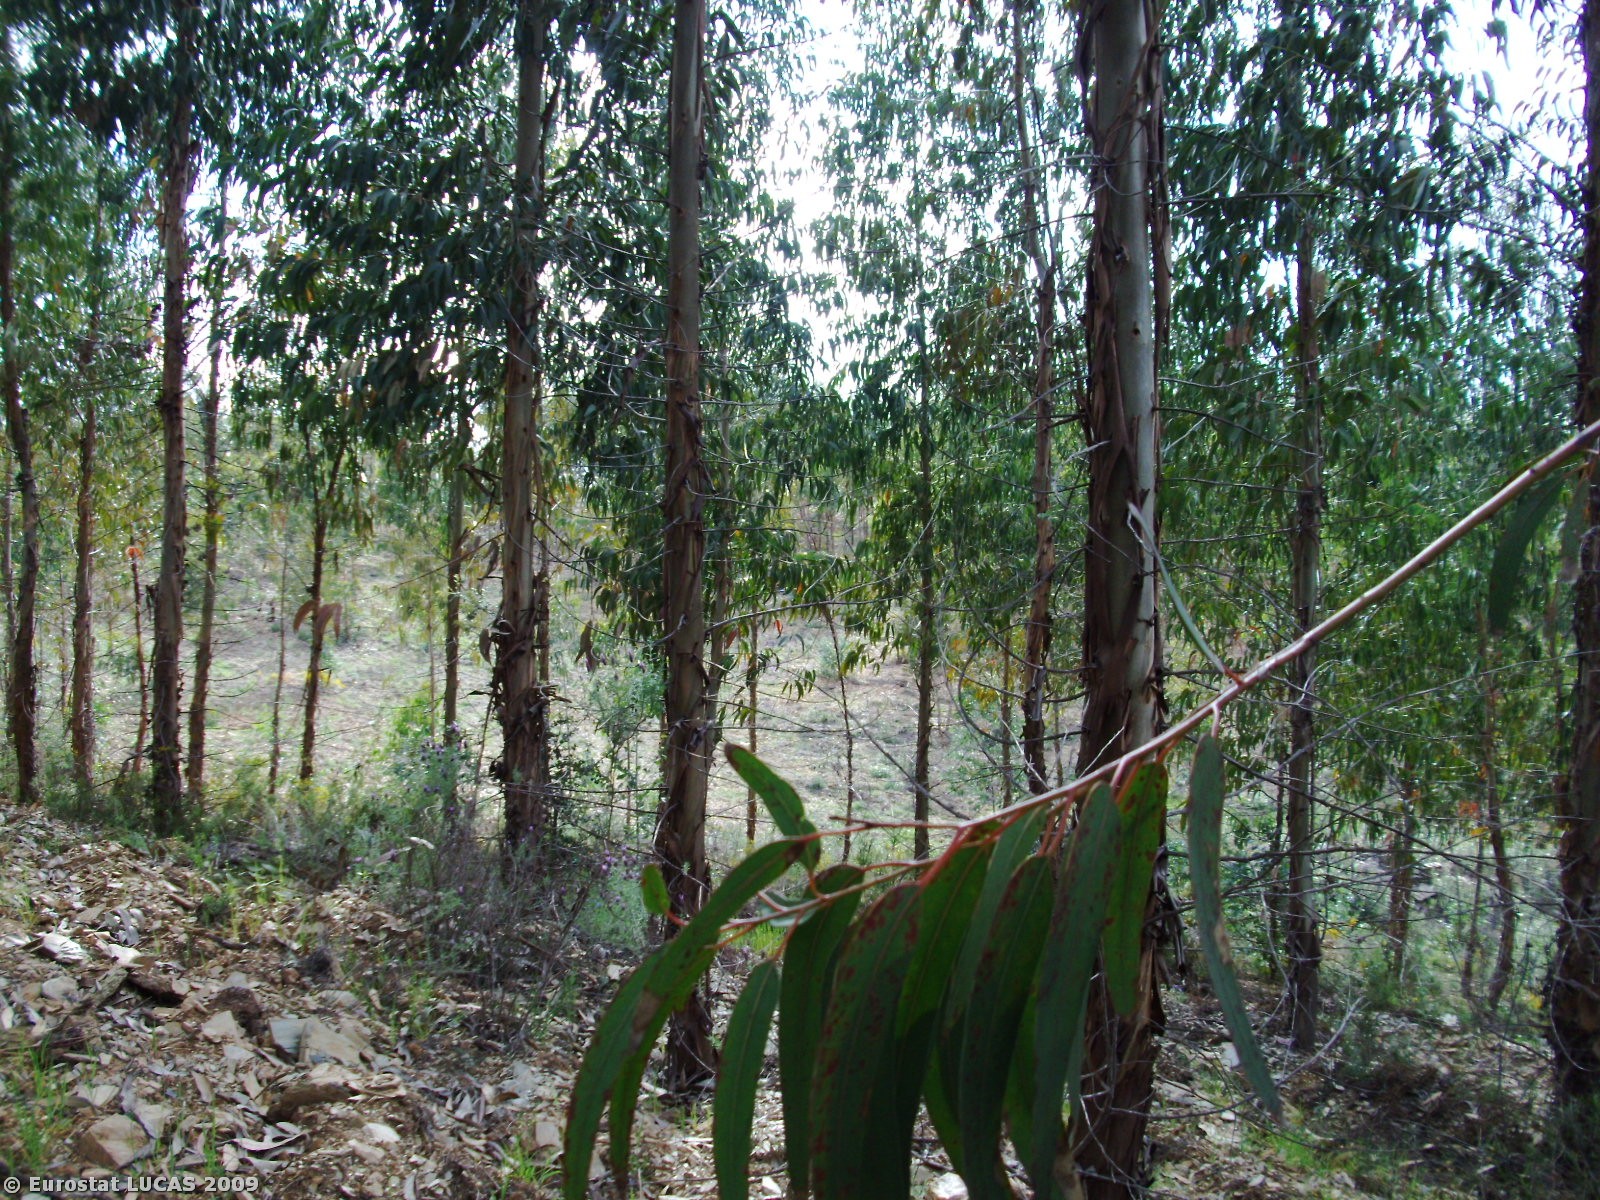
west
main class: Woodland
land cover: Broadleaved woodland
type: plantations and self-sown exotic forest
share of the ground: 25 - 50 %
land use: Forestry
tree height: > 5 m
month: April
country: PT
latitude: 39.8092
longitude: -7.5873
